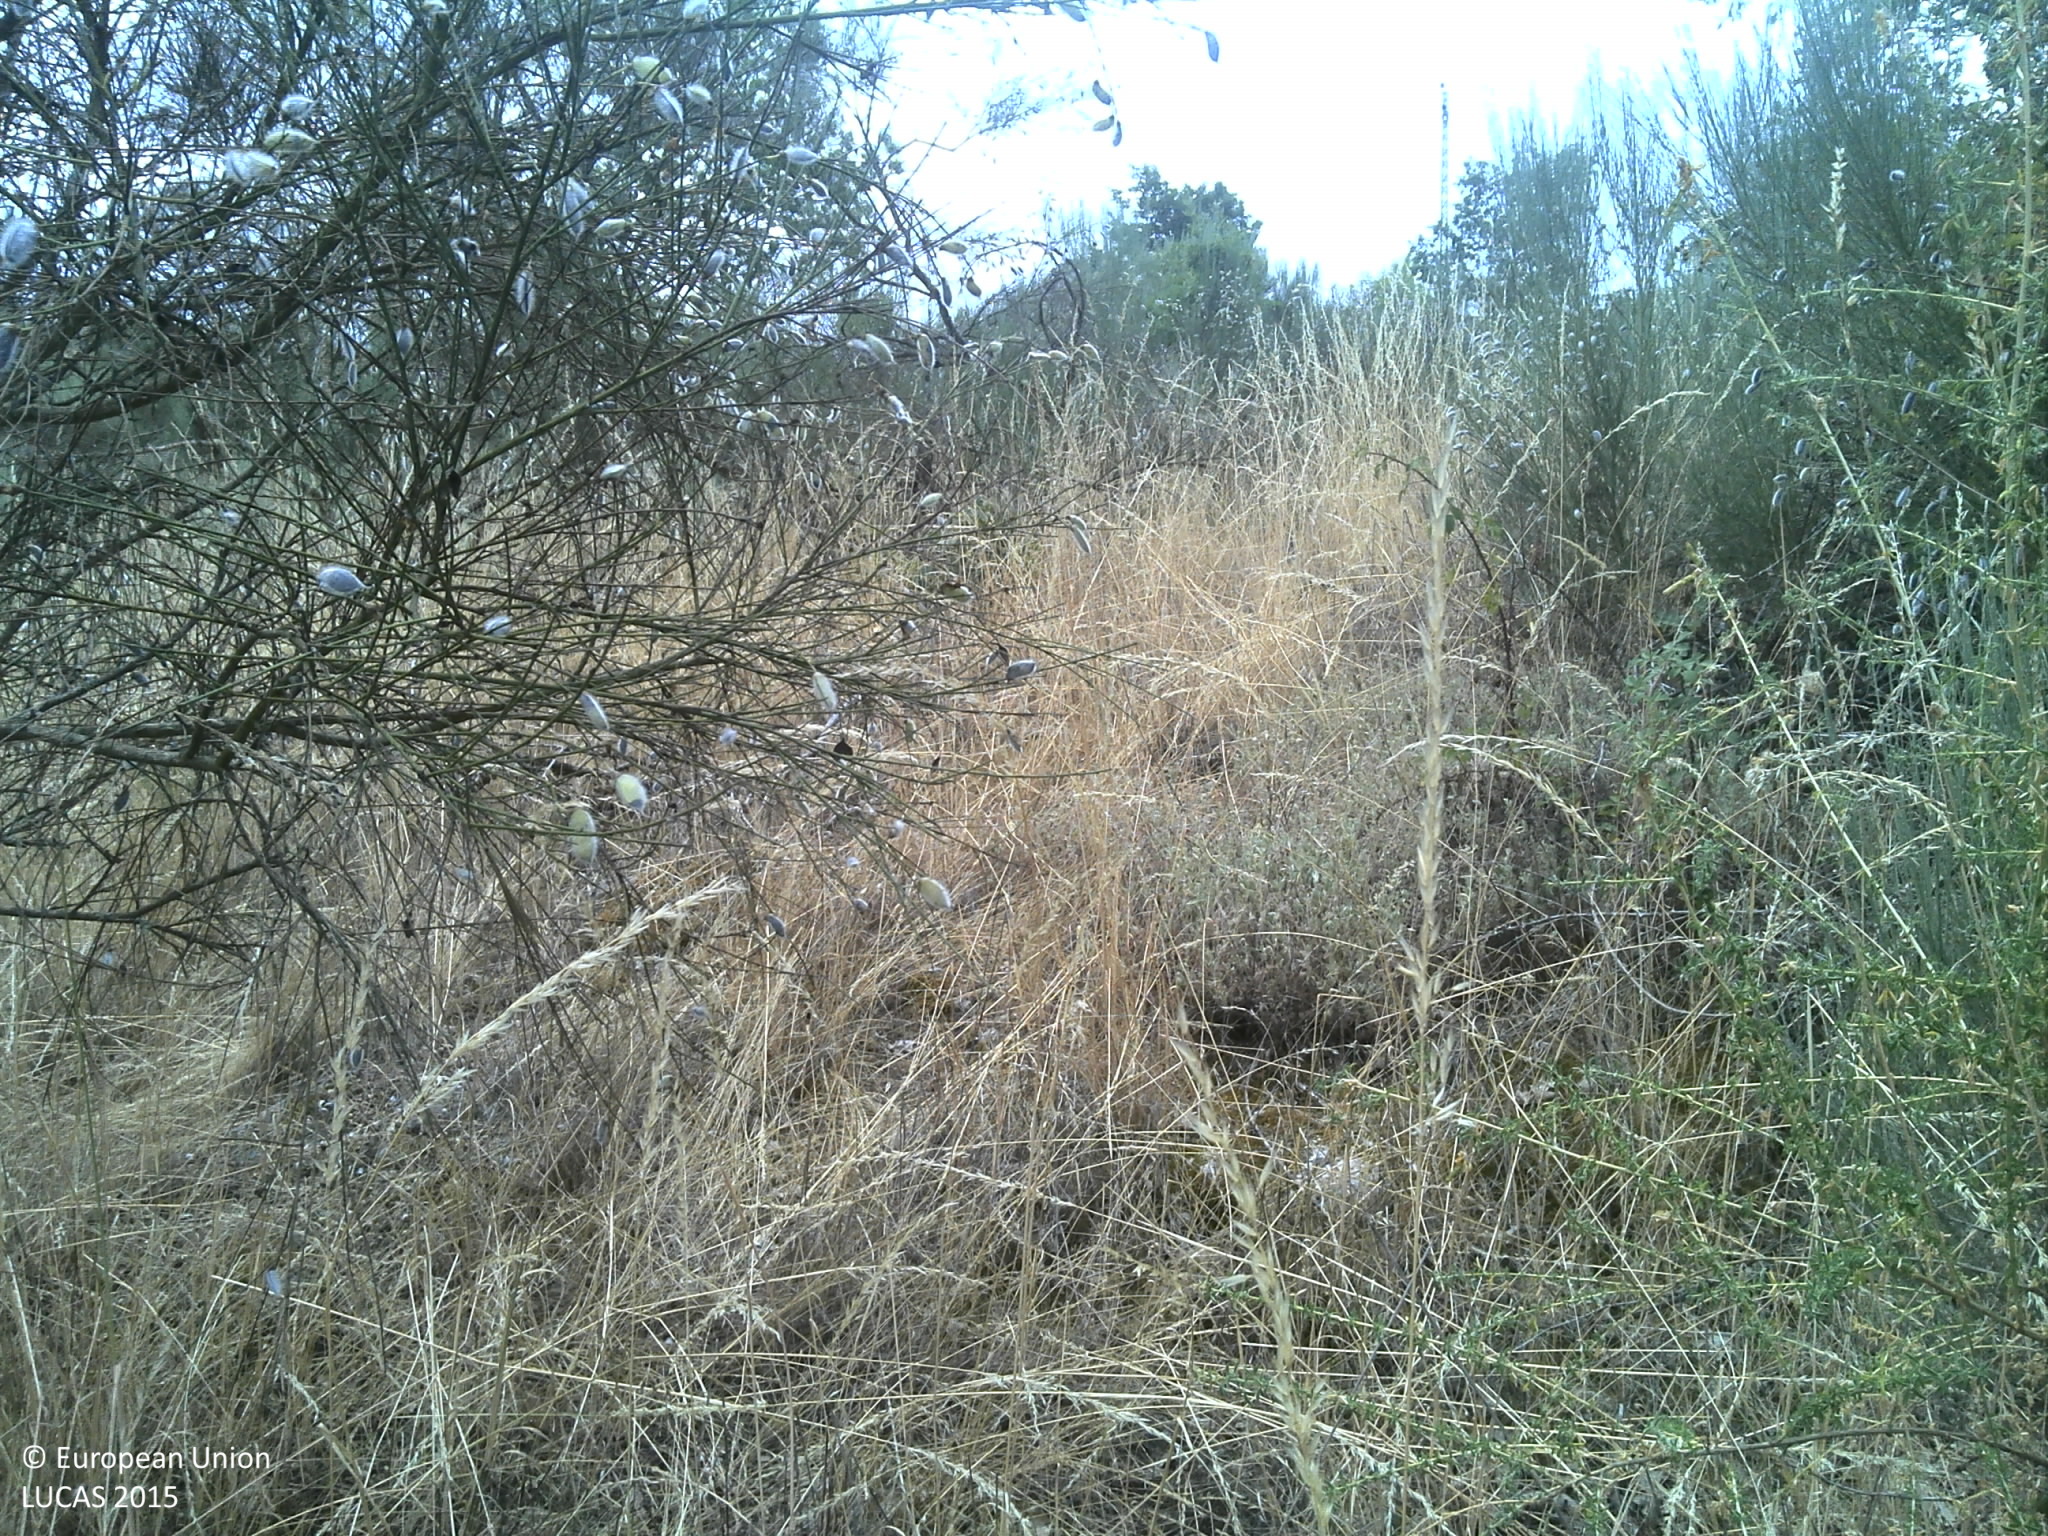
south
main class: Woodland
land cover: Broadleaved woodland
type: mesophytic deciduous forest
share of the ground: 25 - 50 %
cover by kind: shrubs 60 %, broadleaved forest trees 35 %, unconsolidated bare surface 5 %
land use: Semi-natural and natural areas not in use
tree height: > 5 m
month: July
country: PT
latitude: 40.9756
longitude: -7.3591
